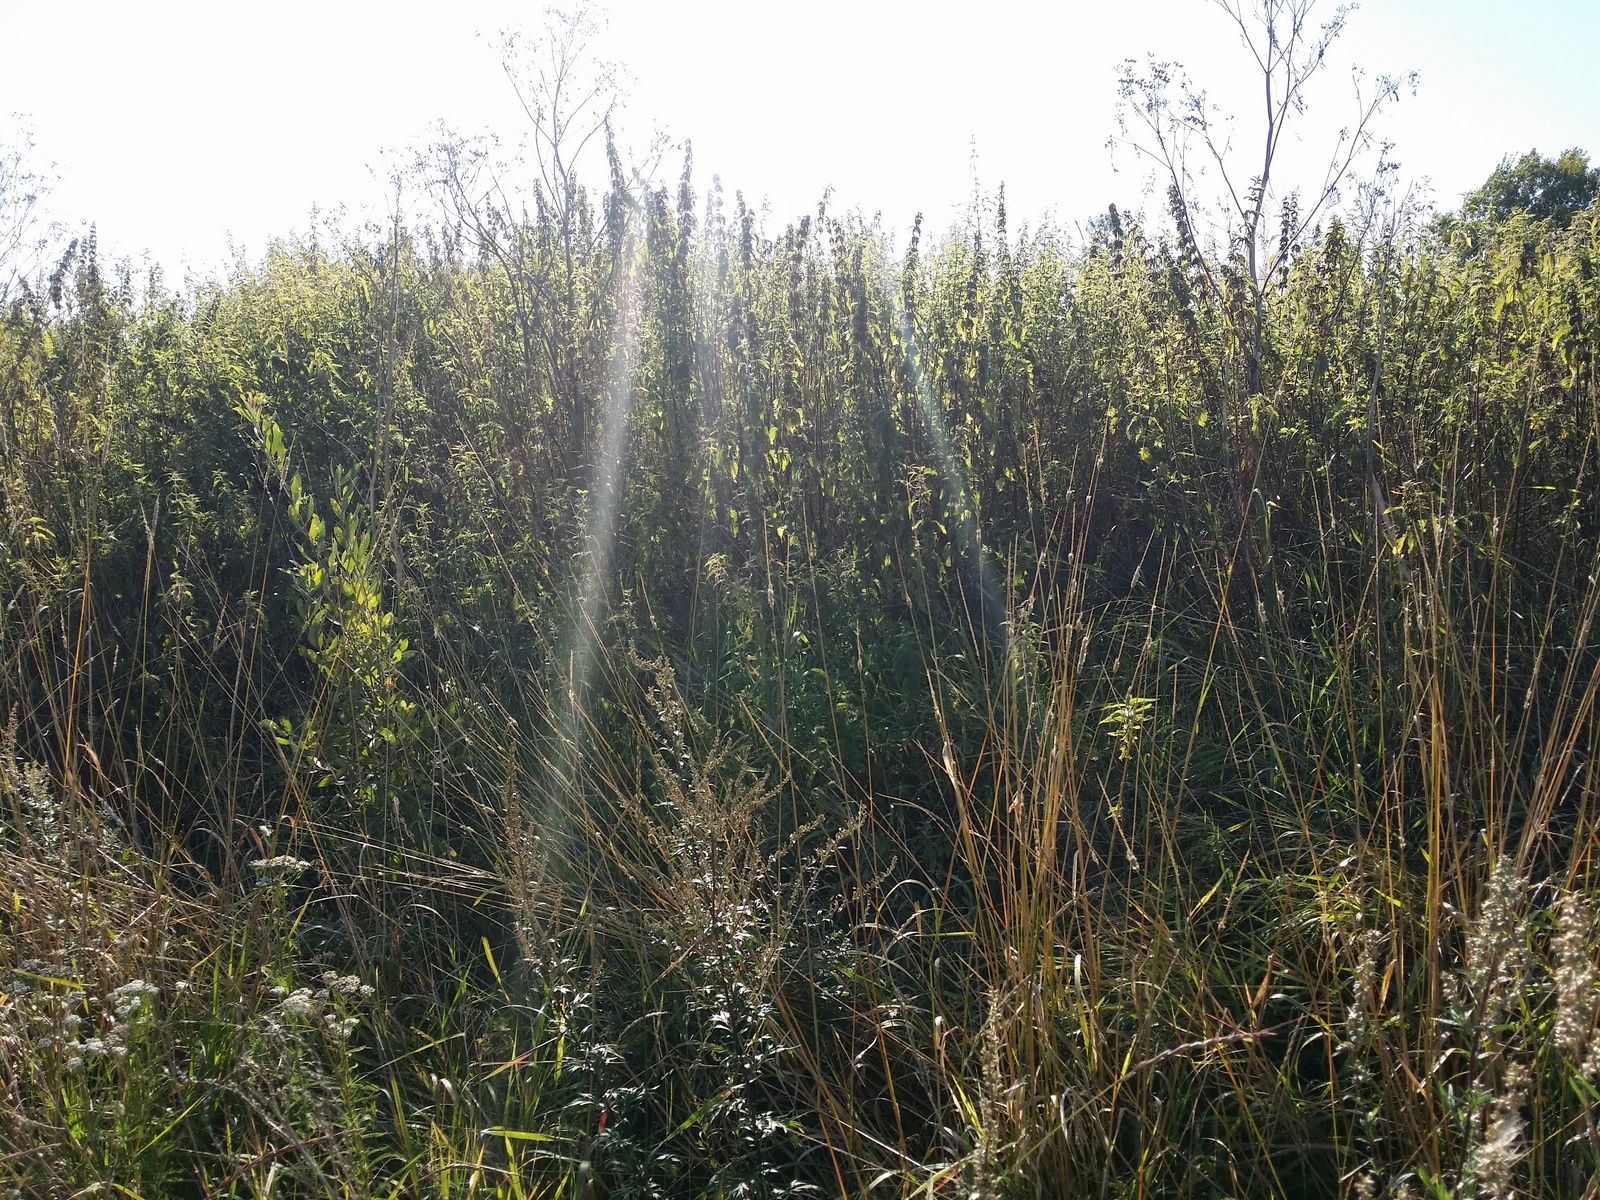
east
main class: Grassland
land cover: Spontaneously vegetated surfaces
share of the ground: > 75 %
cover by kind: herbaceous plants 100 %
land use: Semi-natural and natural areas not in use
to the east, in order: Spontaneously vegetated surfaces; Grass margins; Tracks; Grass margins; Abandoned hedges; Spontaneously vegetated surfaces; Grassland with sparse tree/shrub cover; Paved roads, cycling and walking lanes; Grass margins; Broadleaved woodland; Spontaneously vegetated surfaces; Fences; Grassland without tree/shrub cover; Fences; Grassland without tree/shrub cover
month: August
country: LV
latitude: 57.1729
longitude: 27.7320
